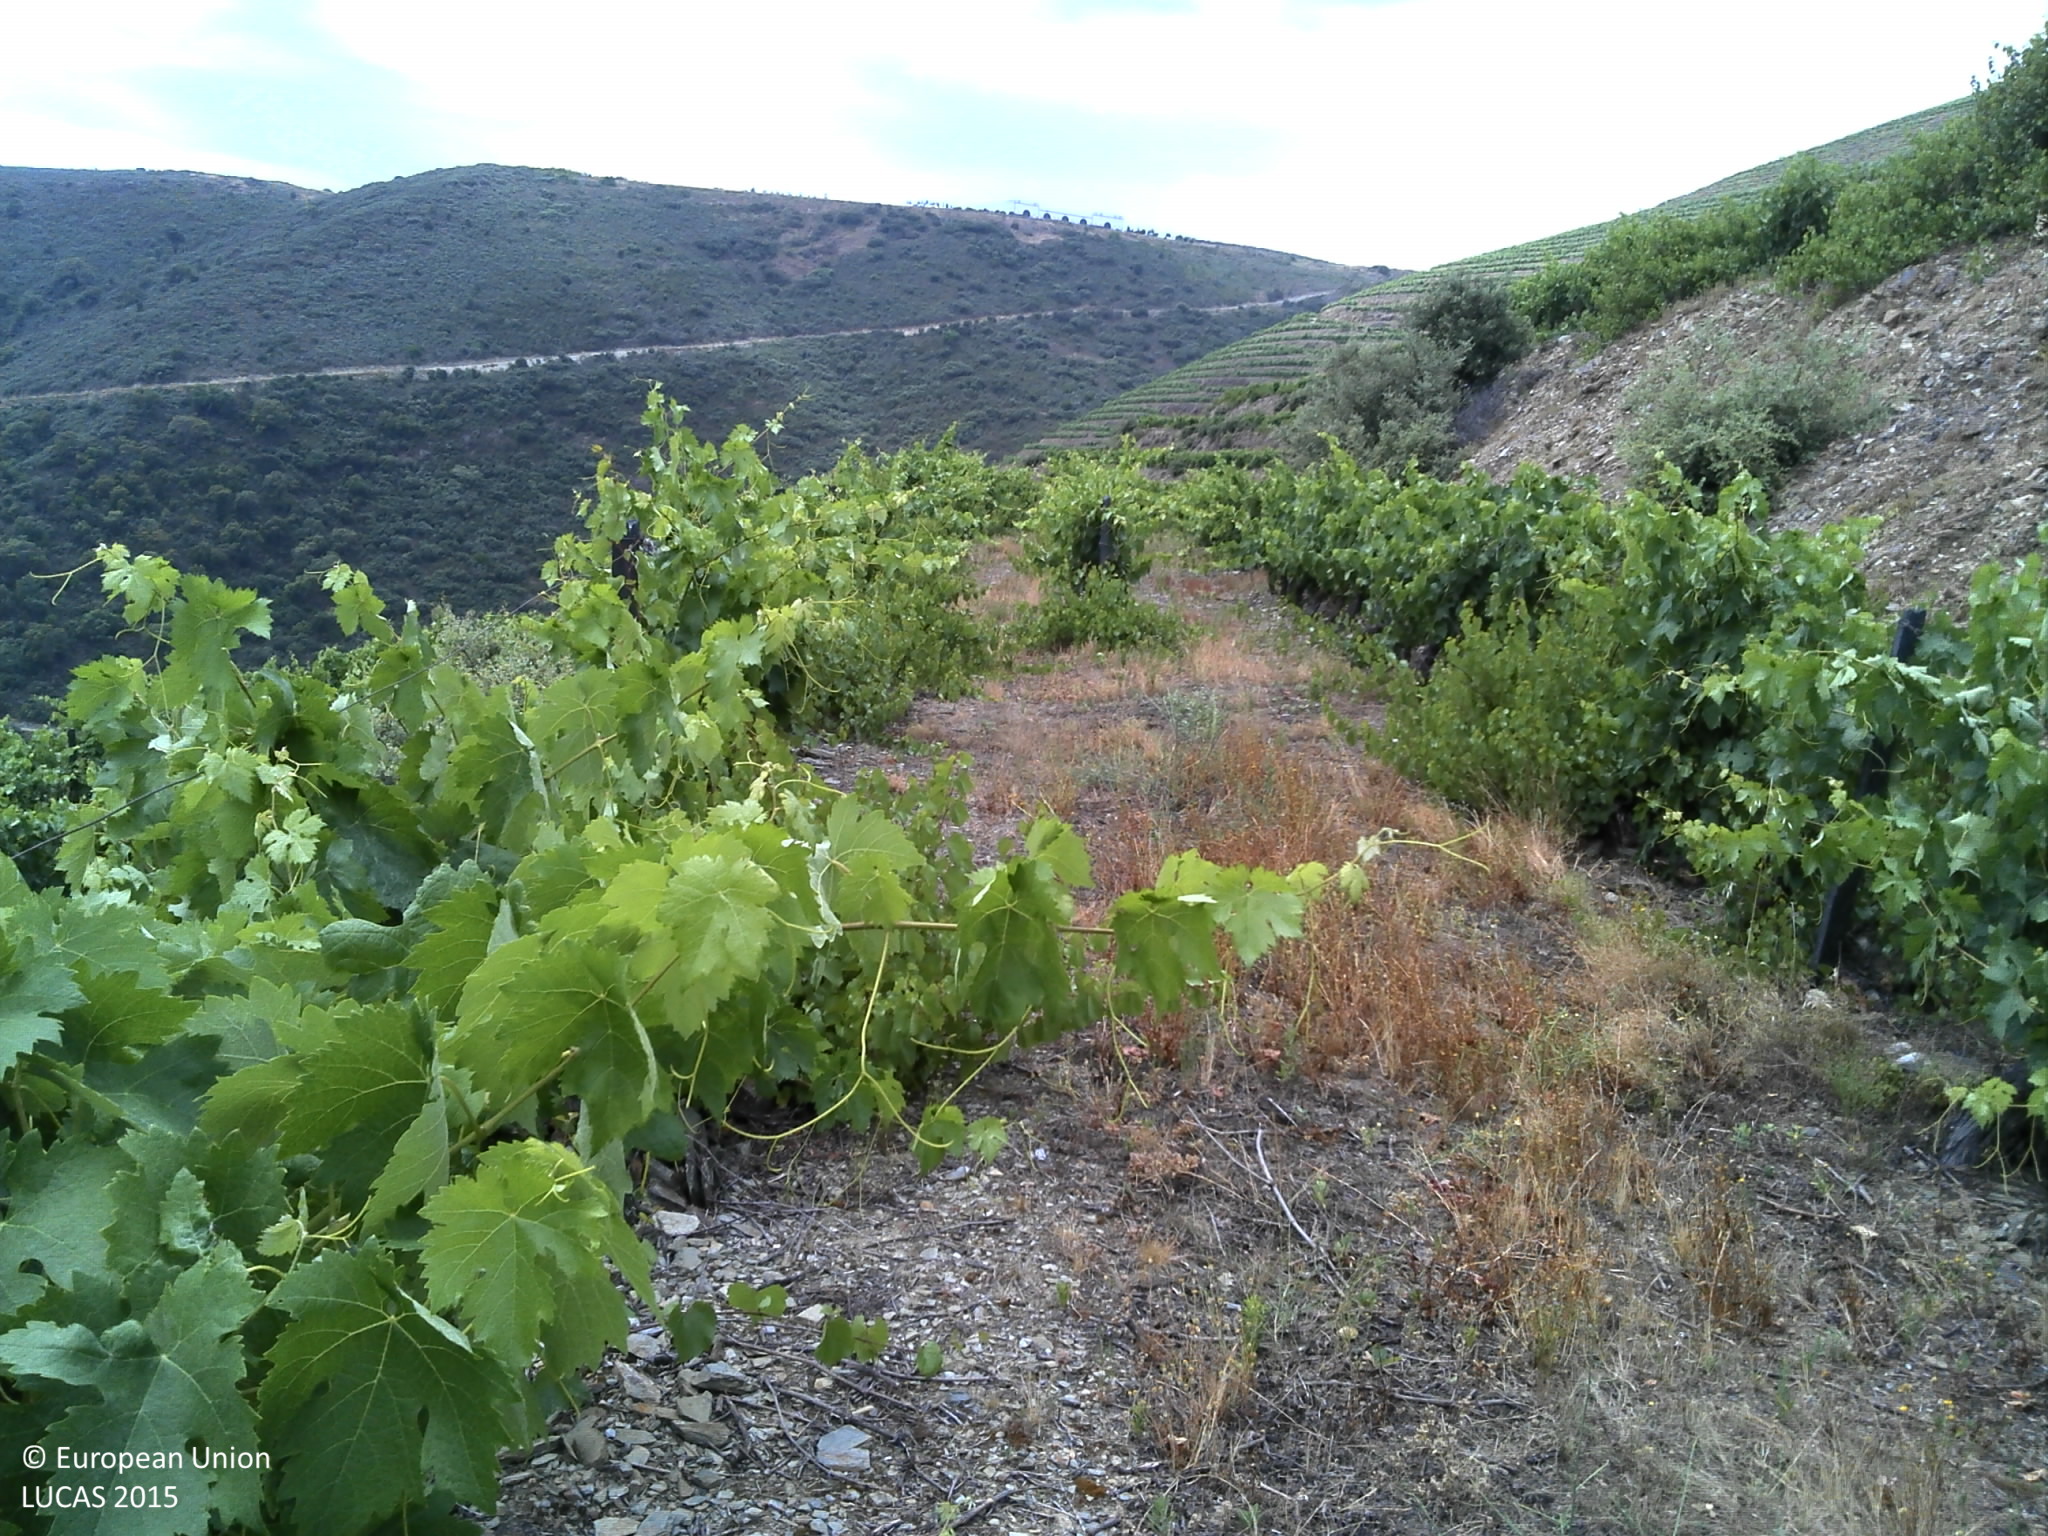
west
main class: Cropland
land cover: Vineyards
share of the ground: < 10 %
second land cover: Spontaneously vegetated surfaces
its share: 25 - 50 %
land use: Agriculture (excluding fallow land and kitchen gardens)
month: June
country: PT
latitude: 41.1201
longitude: -7.3758
